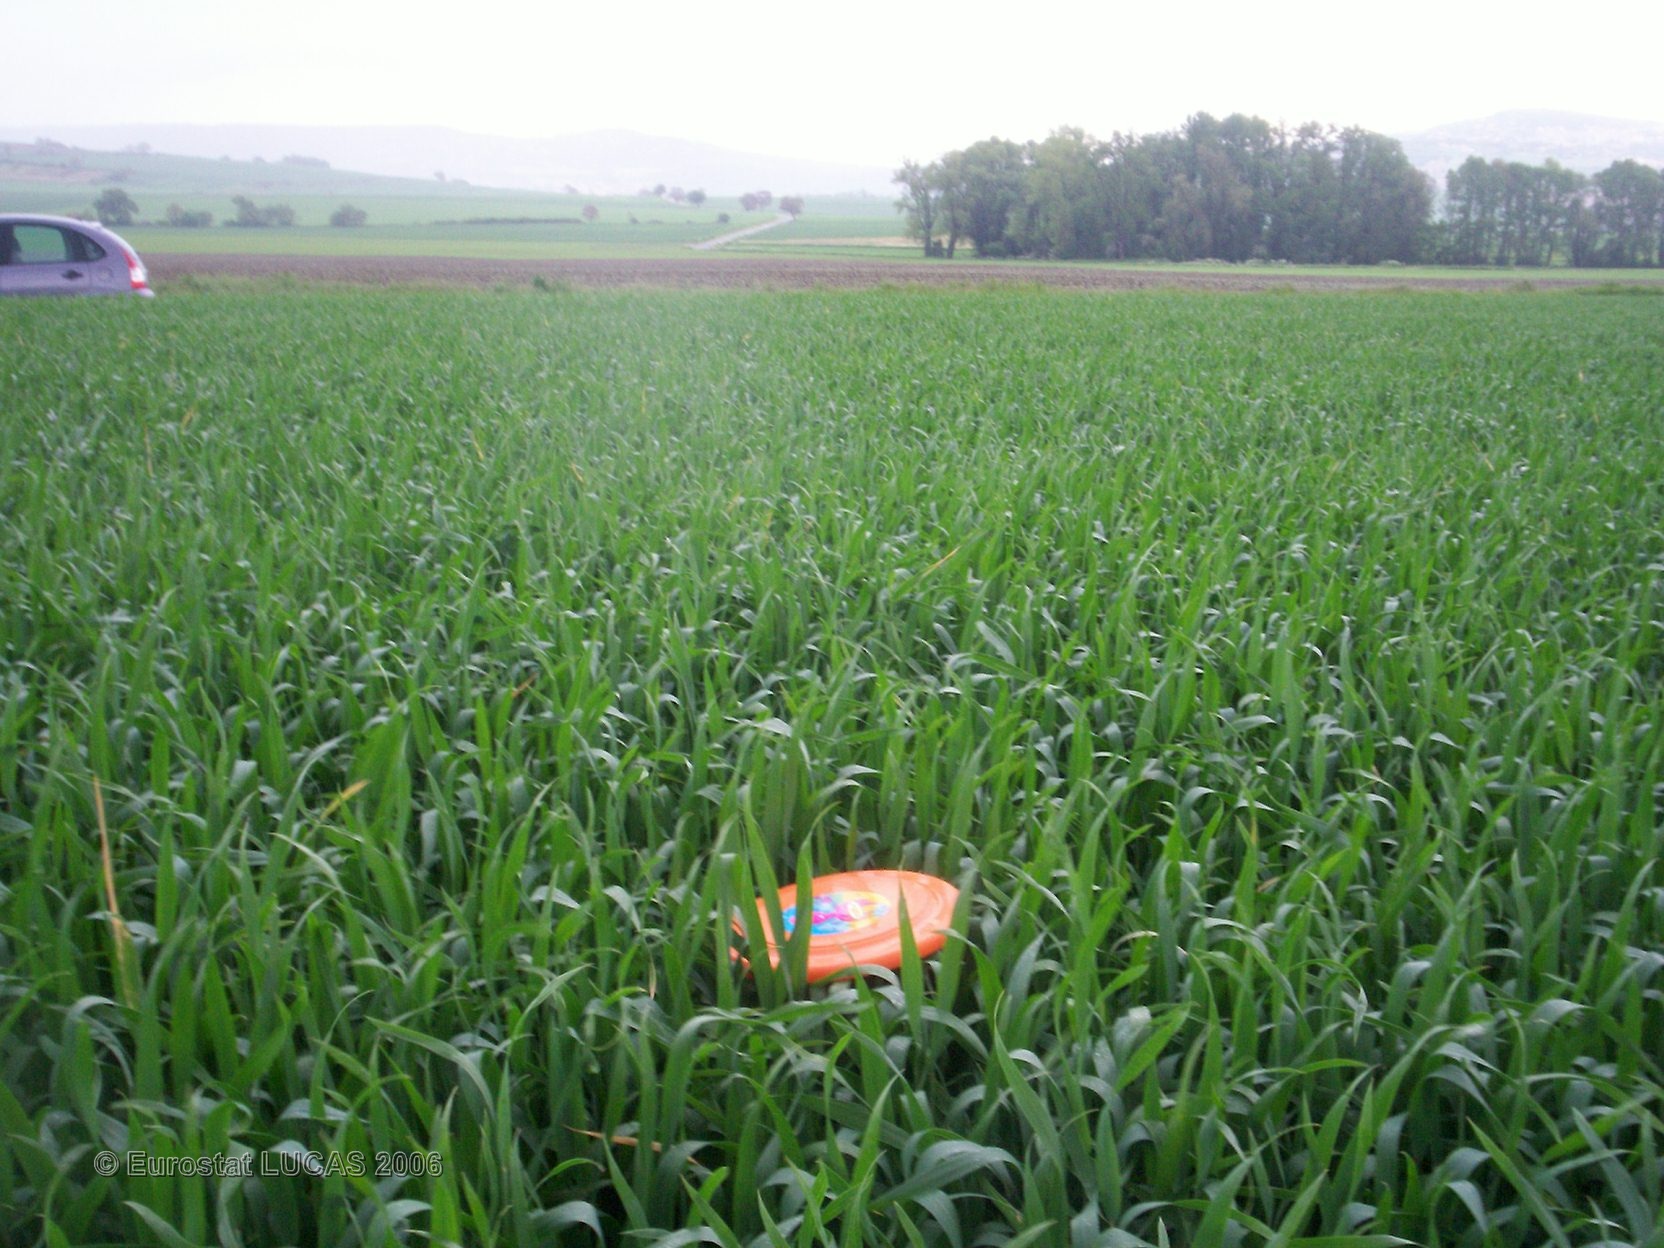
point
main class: Cropland
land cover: Common wheat
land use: Agriculture (excluding fallow land and kitchen gardens)
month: May
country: FR
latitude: 45.6425
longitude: 3.1362
